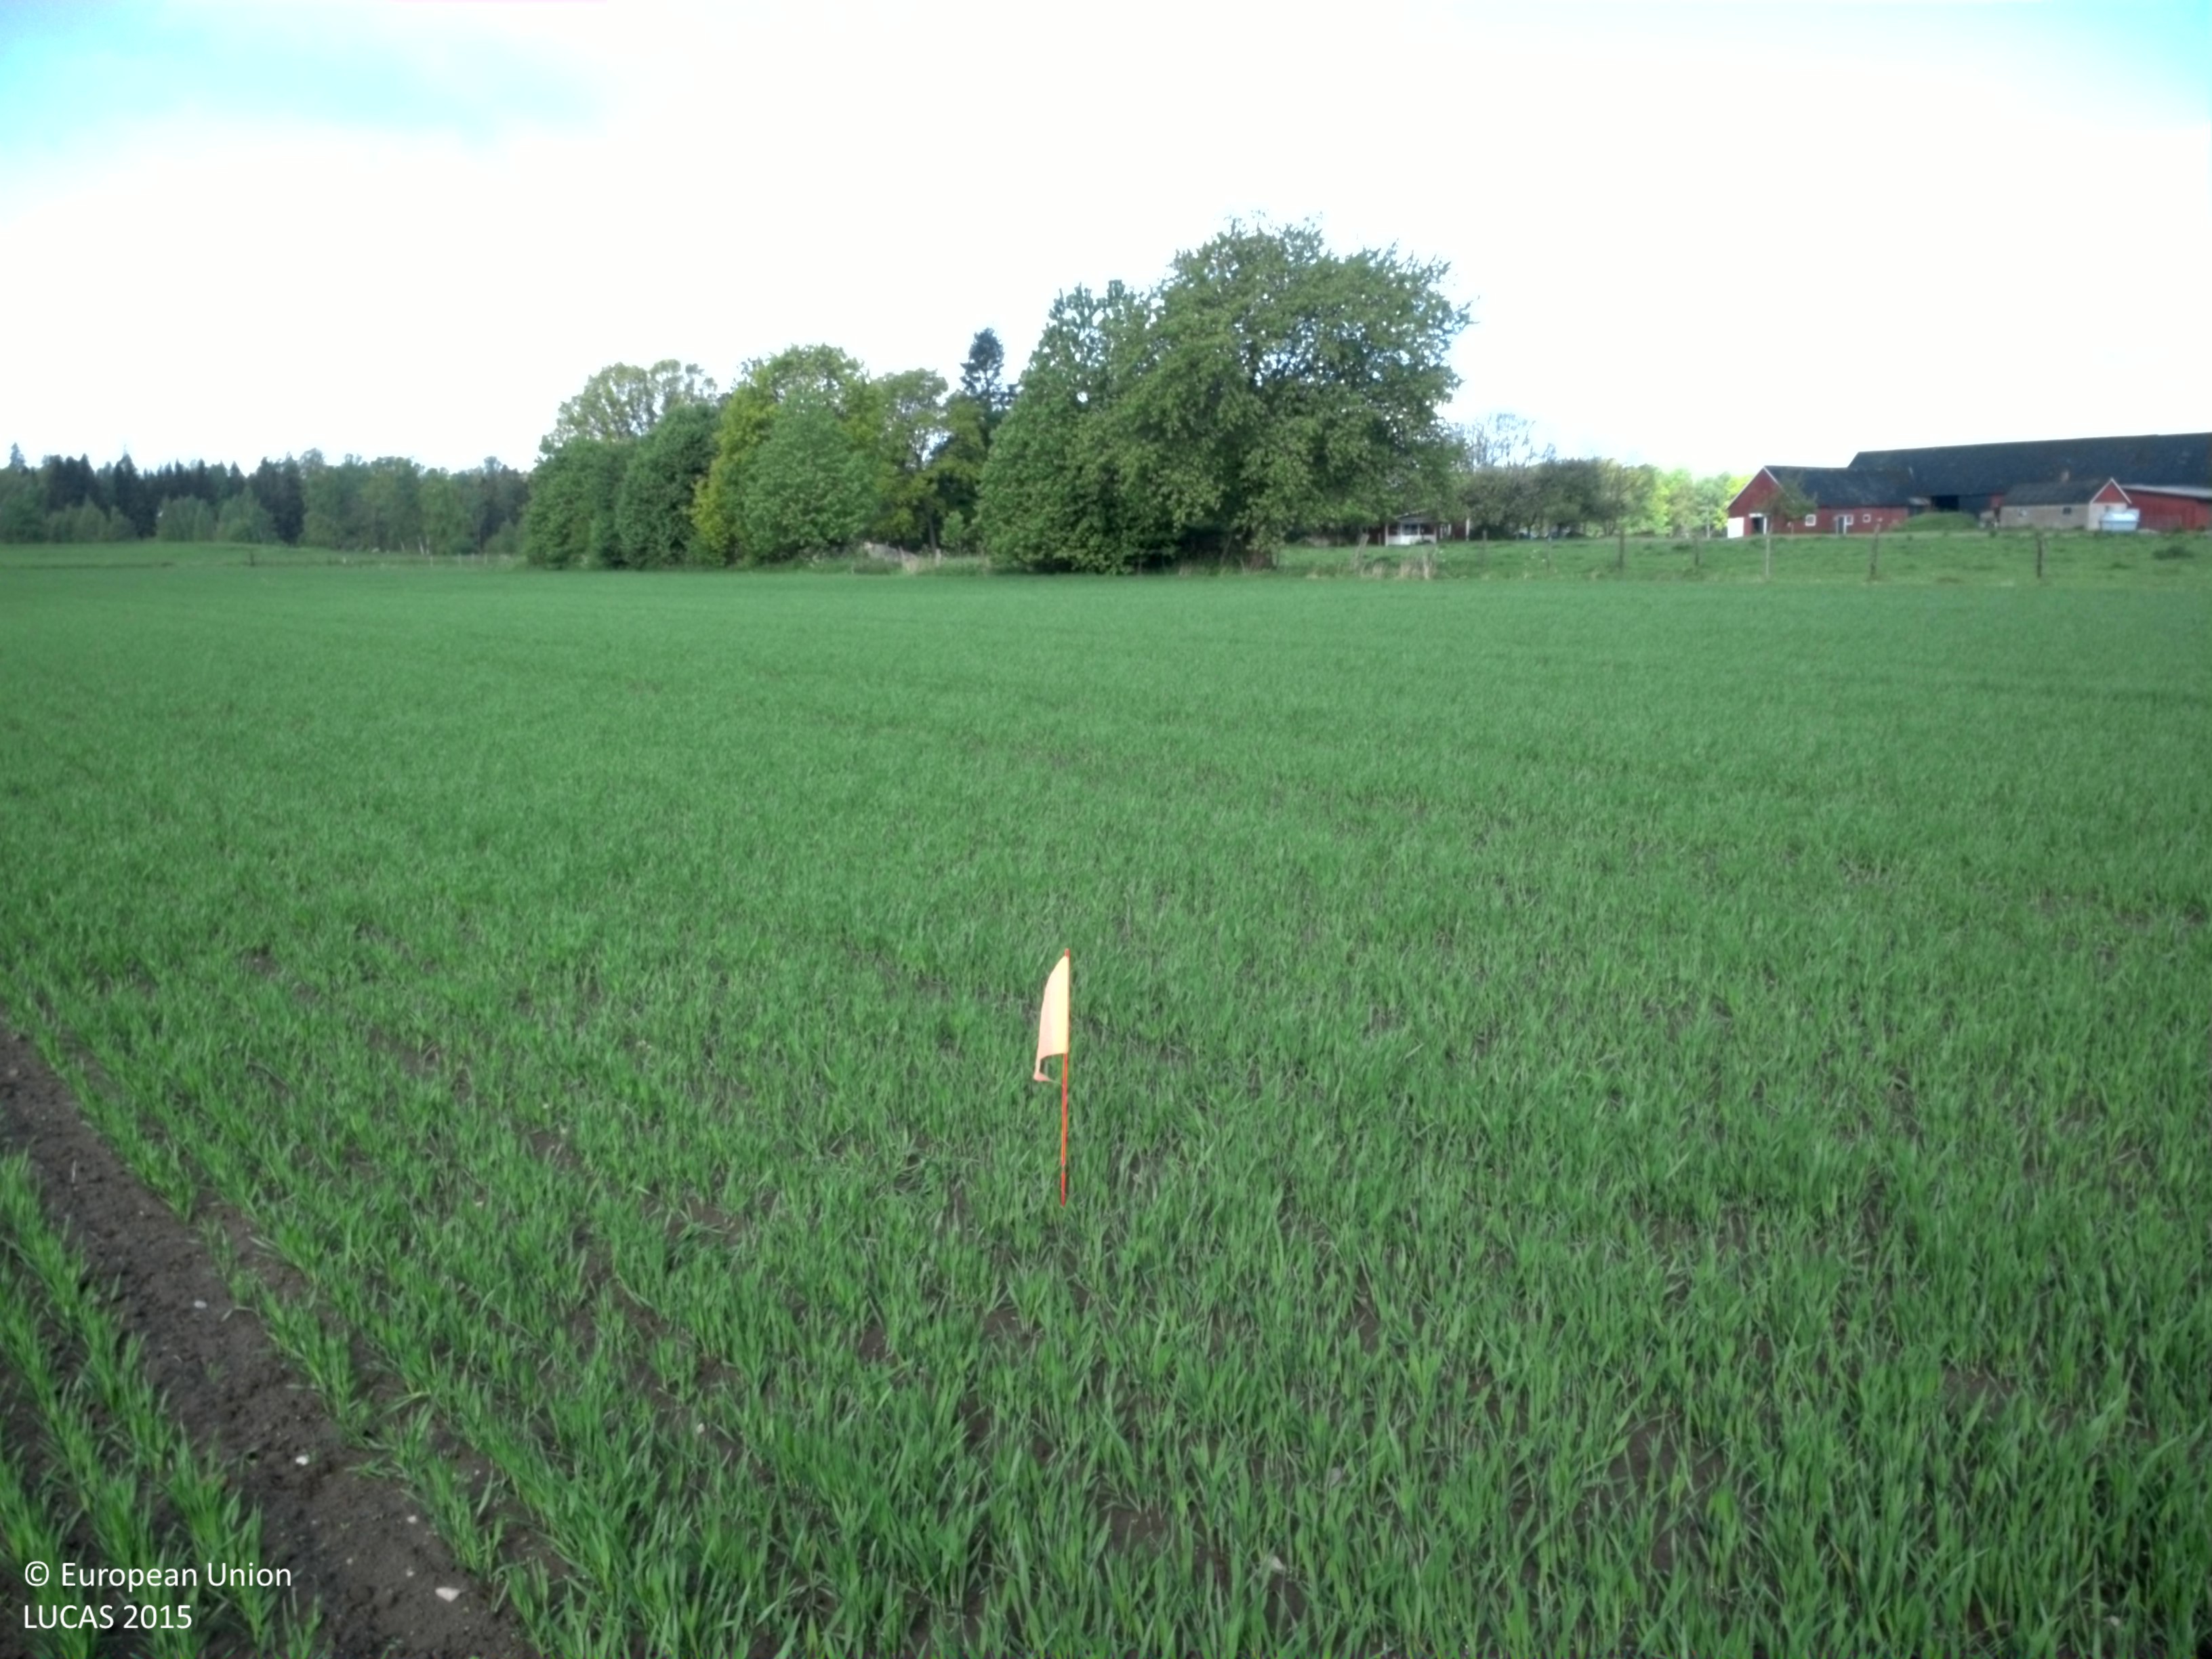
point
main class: Cropland
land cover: Oats
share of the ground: 50 - 75 %
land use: Agriculture (excluding fallow land and kitchen gardens)
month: June
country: SE
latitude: 56.7181
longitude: 14.5885
